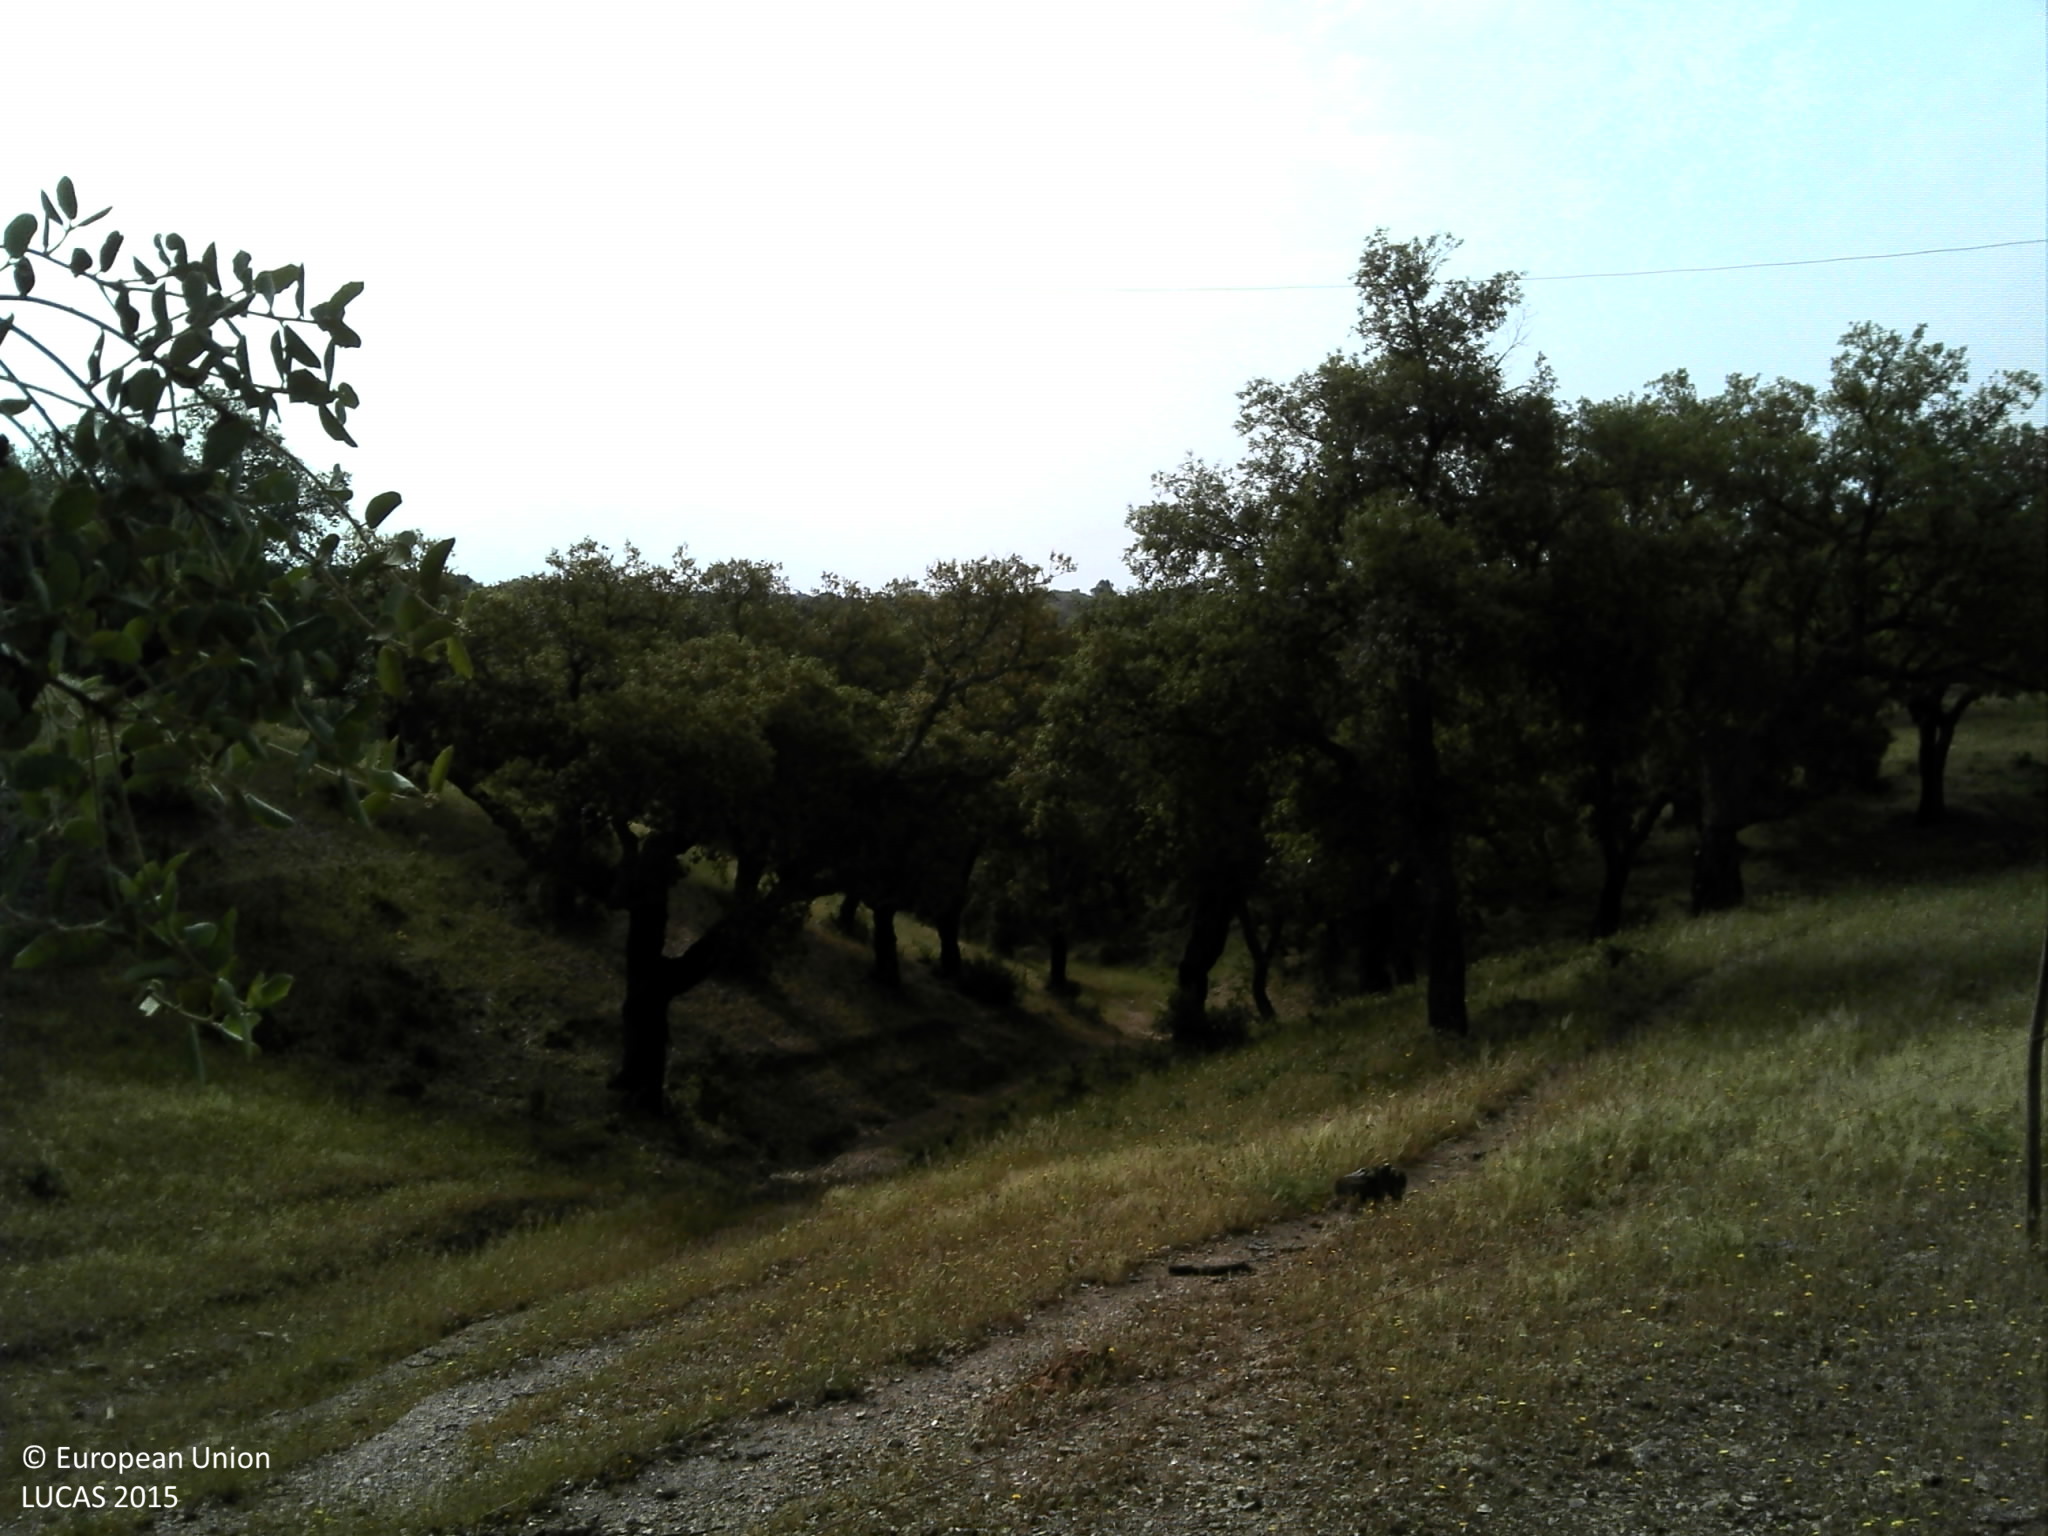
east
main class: Woodland
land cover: Broadleaved woodland
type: broadleaved evergreen forest
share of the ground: 25 - 50 %
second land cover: Grassland without tree/shrub cover
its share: 25 - 50 %
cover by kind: unconsolidated bare surface 40 %, broadleaved forest trees 30 %, herbaceous plants 30 %
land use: Agriculture (excluding fallow land and kitchen gardens)
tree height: > 5 m
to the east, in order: Broadleaved woodland; Grassland without tree/shrub cover; Electric lines; Broadleaved woodland; Grass margins; Rivers and streams; Grass margins; Broadleaved woodland
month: May
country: PT
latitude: 38.4423
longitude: -8.4627
